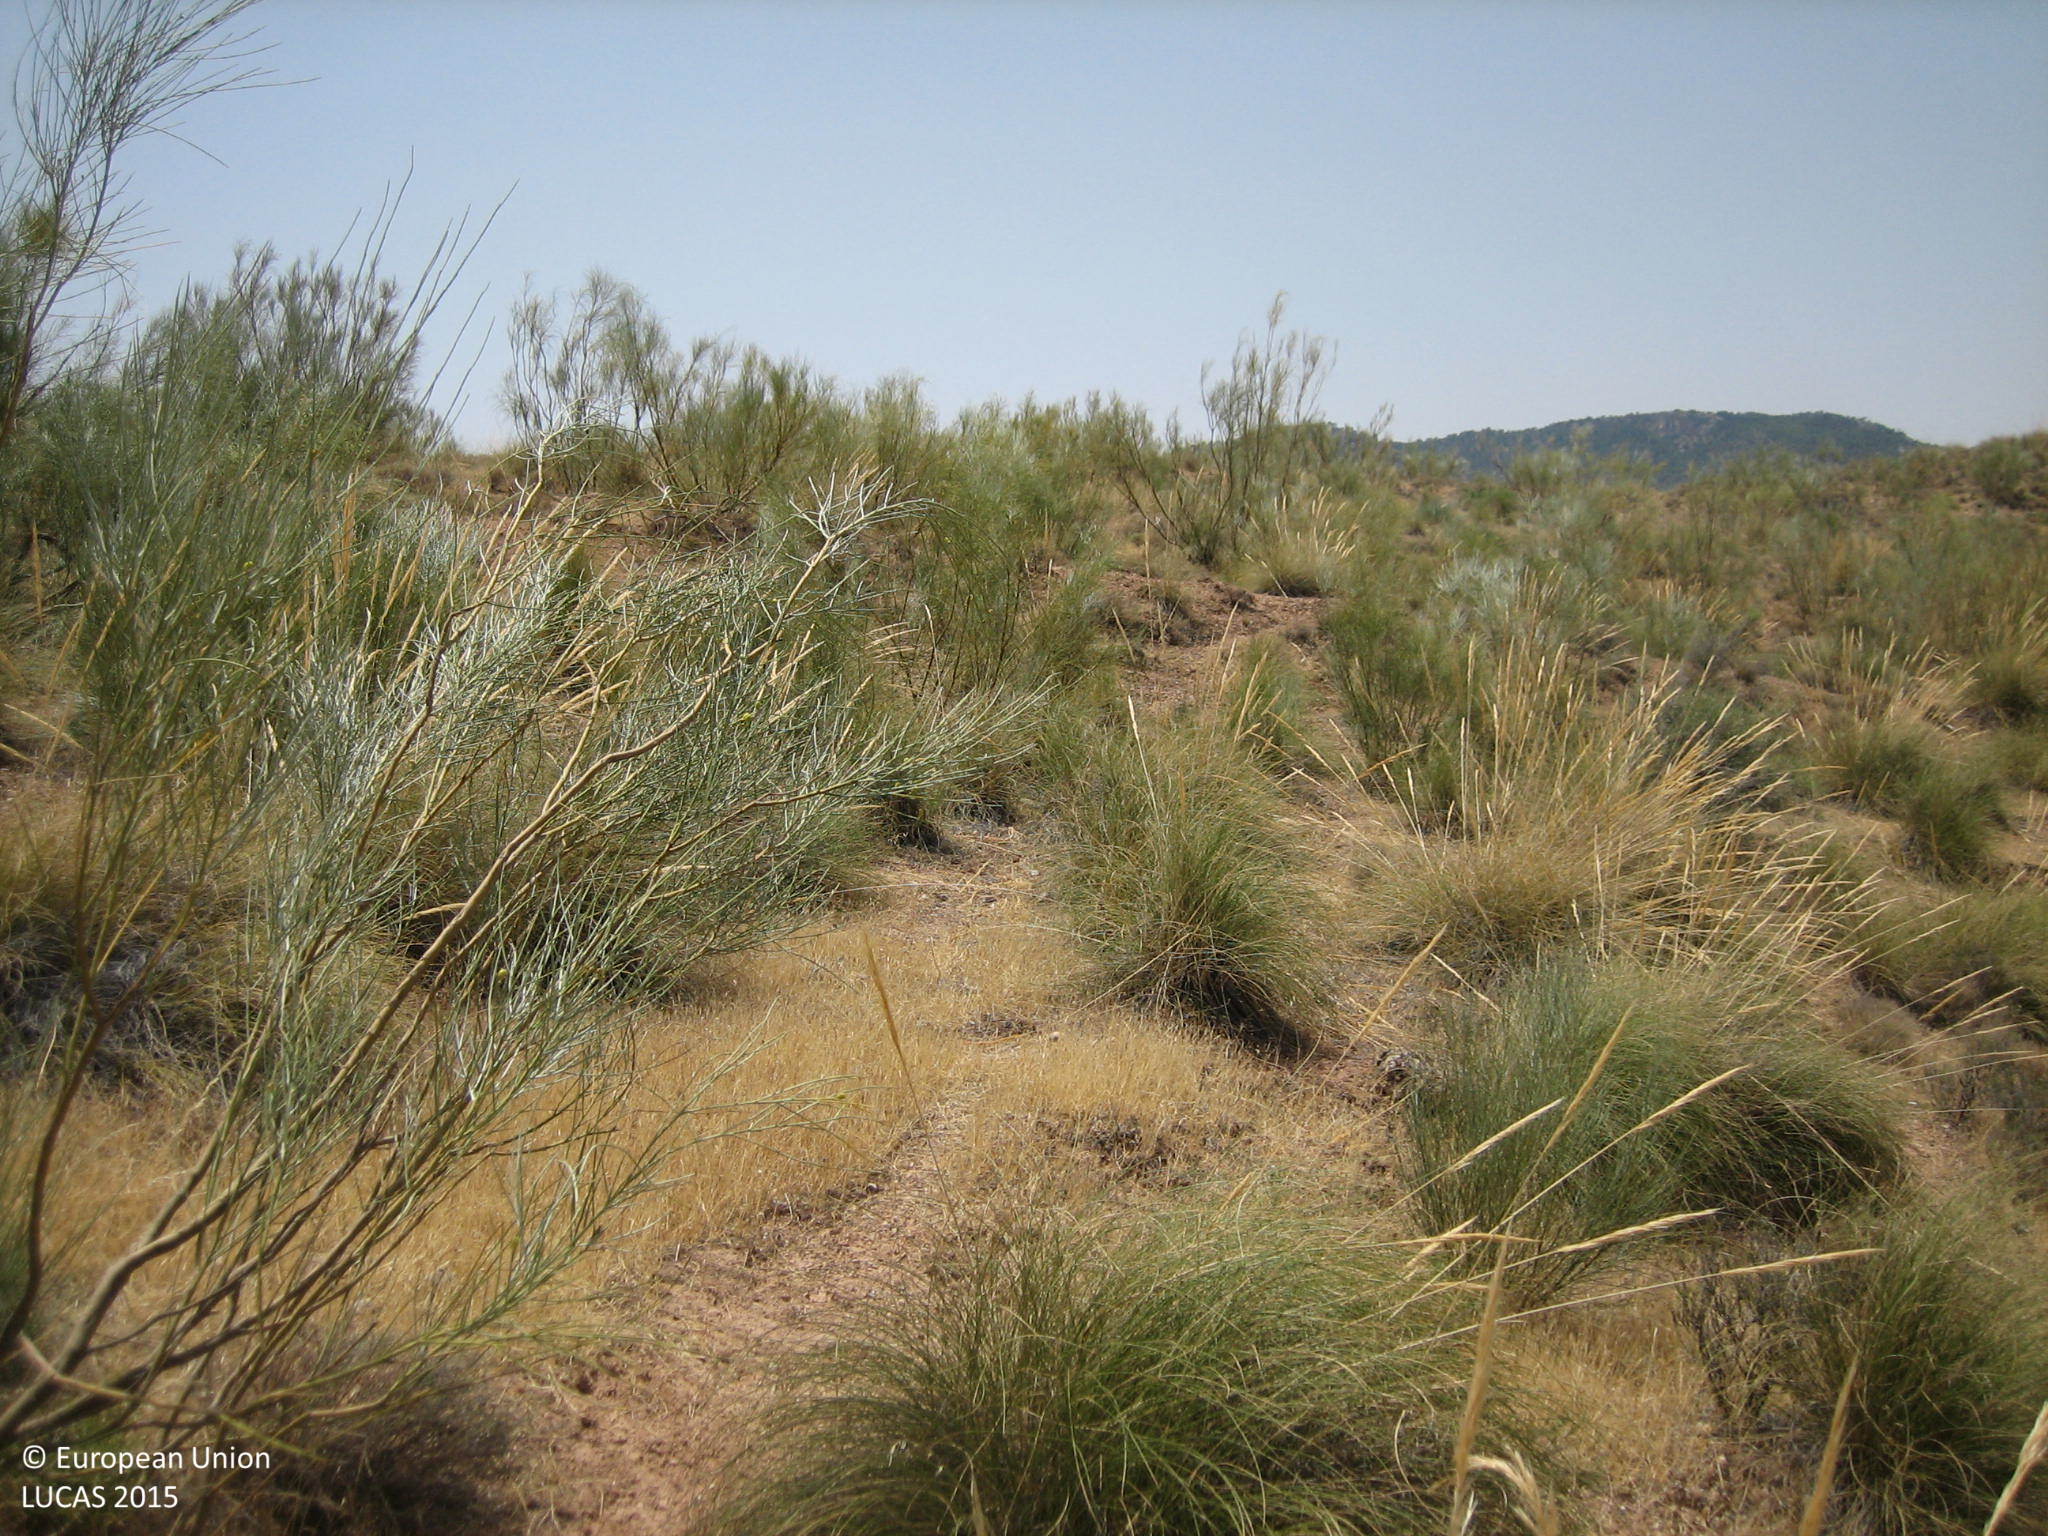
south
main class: Grassland
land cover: Grassland without tree/shrub cover
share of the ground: > 75 %
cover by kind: herbaceous plants 80 %, consolidated bare surface 20 %
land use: Agriculture (excluding fallow land and kitchen gardens)
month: July
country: ES
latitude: 37.6917
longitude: -3.0224
